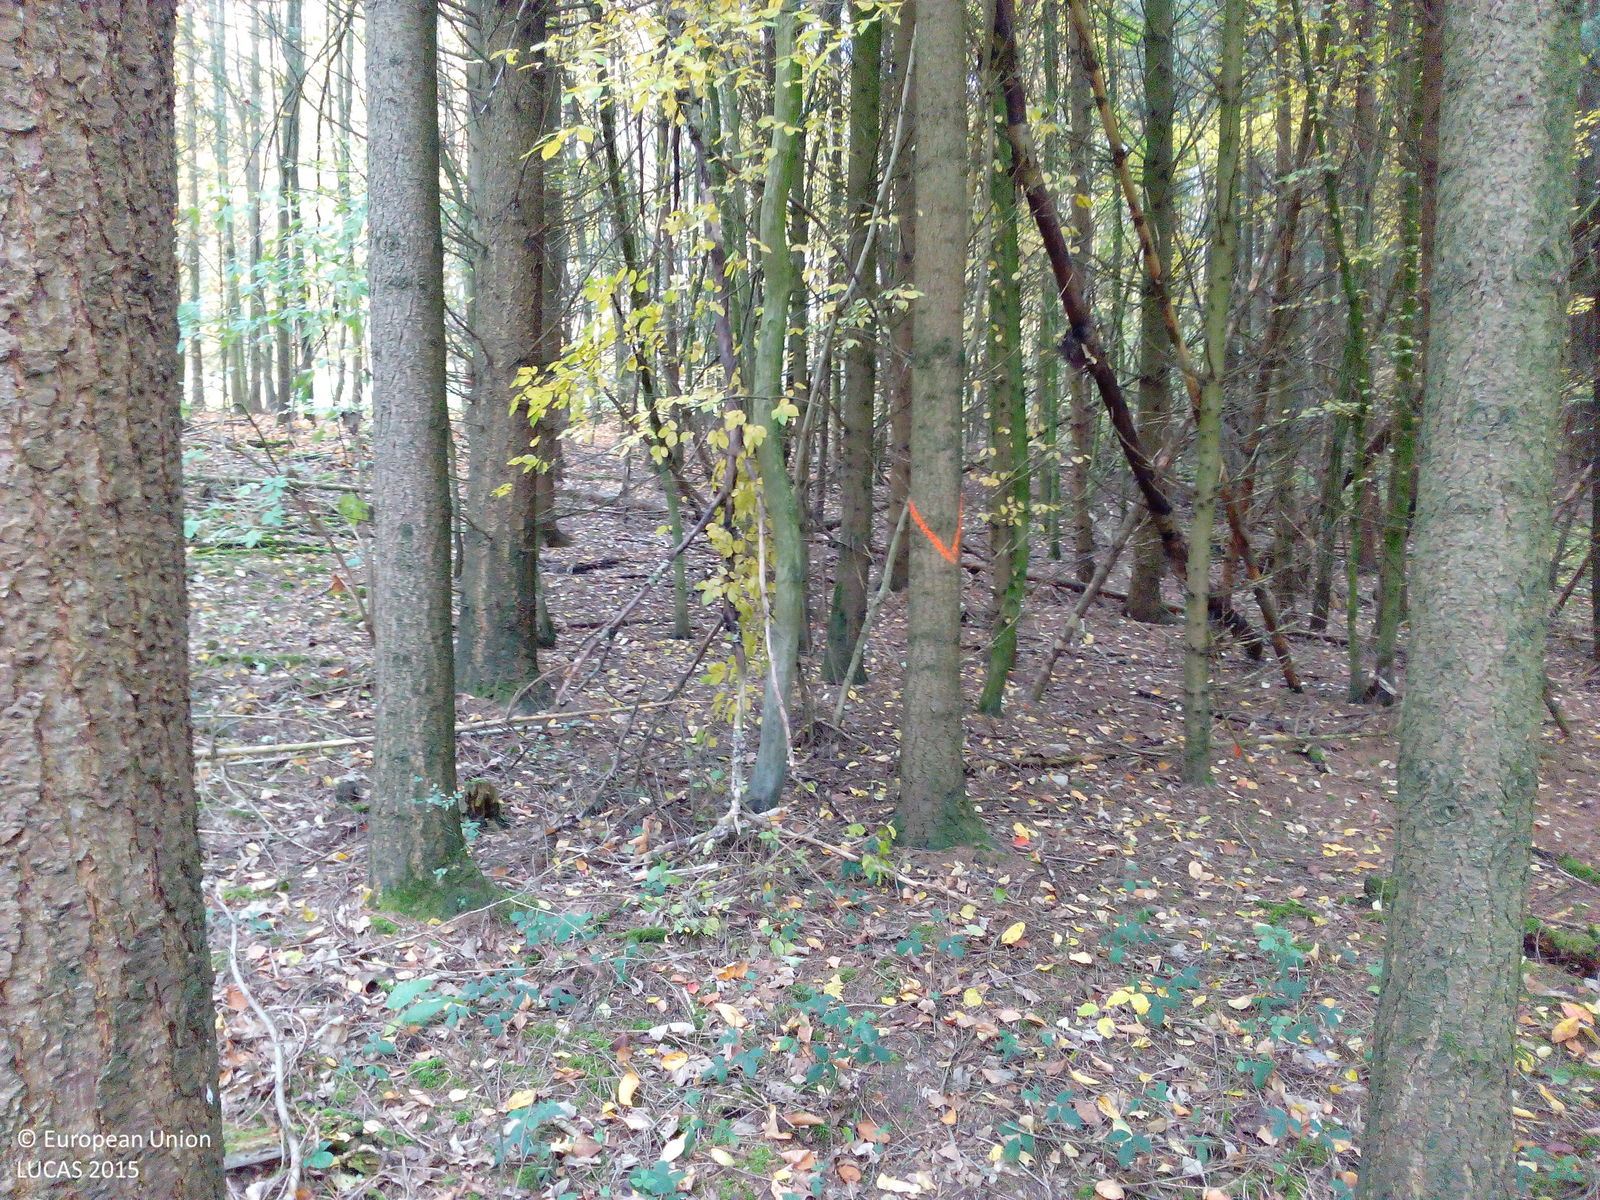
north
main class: Woodland
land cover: Spruce dominated mixed woodland
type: hemiboreal forest and nemoral coniferous forest and mixed broadleaved-coniferous forest
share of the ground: 50 - 75 %
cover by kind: coniferous forest trees 35 %, broadleaved forest trees 25 %, unconsolidated bare surface 20 %, lichens and mosses 15 %, shrubs 5 %
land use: Forestry
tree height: > 5 m
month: October
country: DE
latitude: 50.1662
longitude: 9.9580
